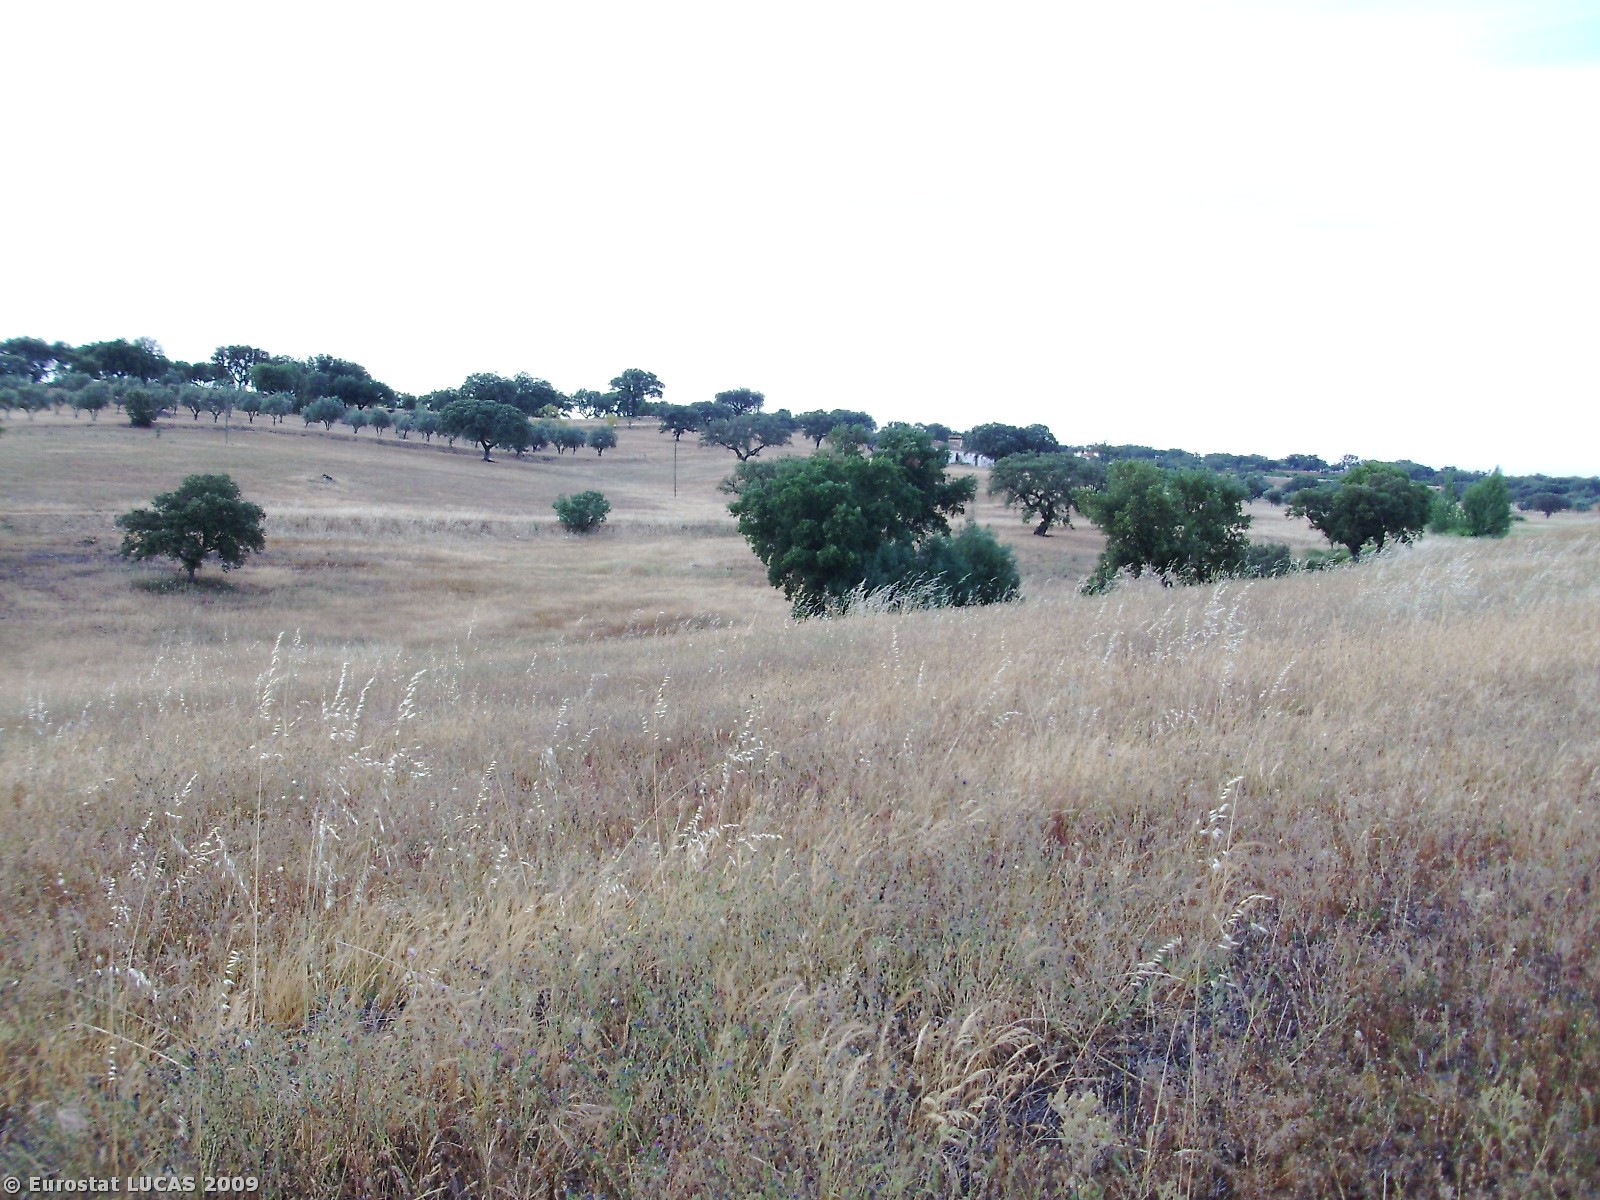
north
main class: Grassland
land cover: Spontaneously vegetated surfaces
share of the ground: > 75 %
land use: Fallow land
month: June
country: PT
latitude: 39.1401
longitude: -7.3092
